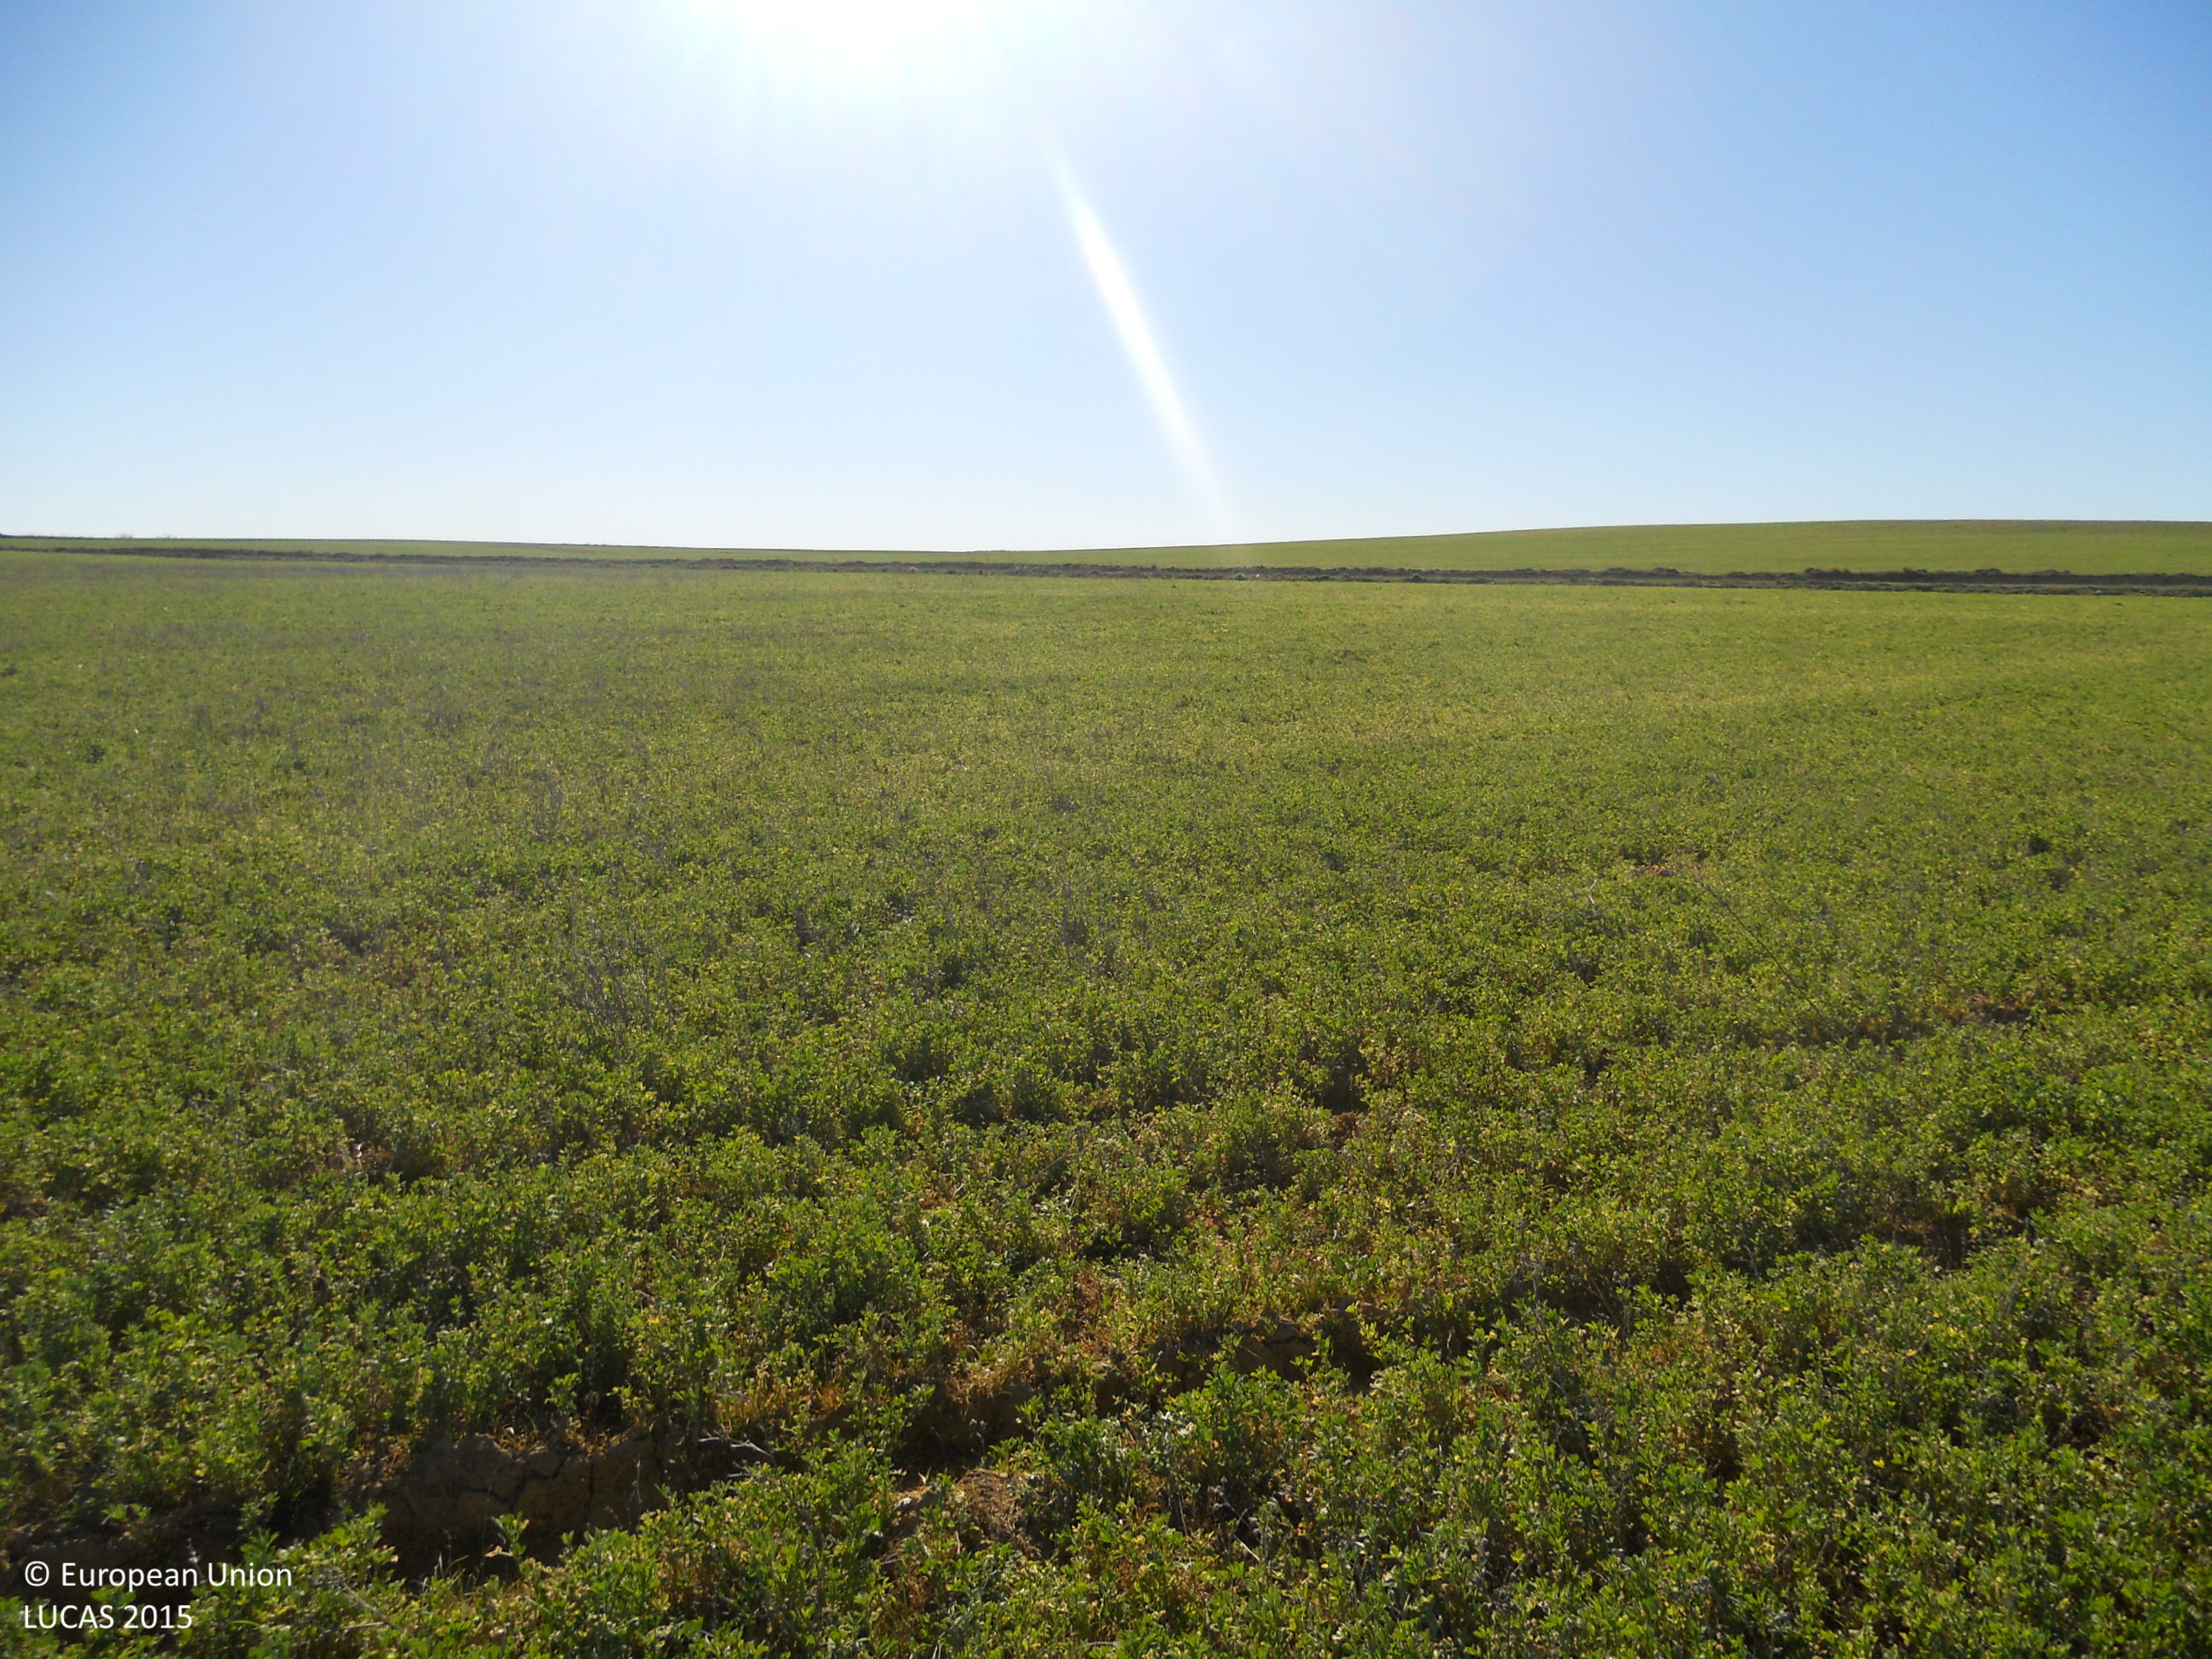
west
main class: Cropland
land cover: Lucerne
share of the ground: > 75 %
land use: Agriculture (excluding fallow land and kitchen gardens)
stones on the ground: < 10 %
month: April
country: ES
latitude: 42.2652
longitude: -4.3636
